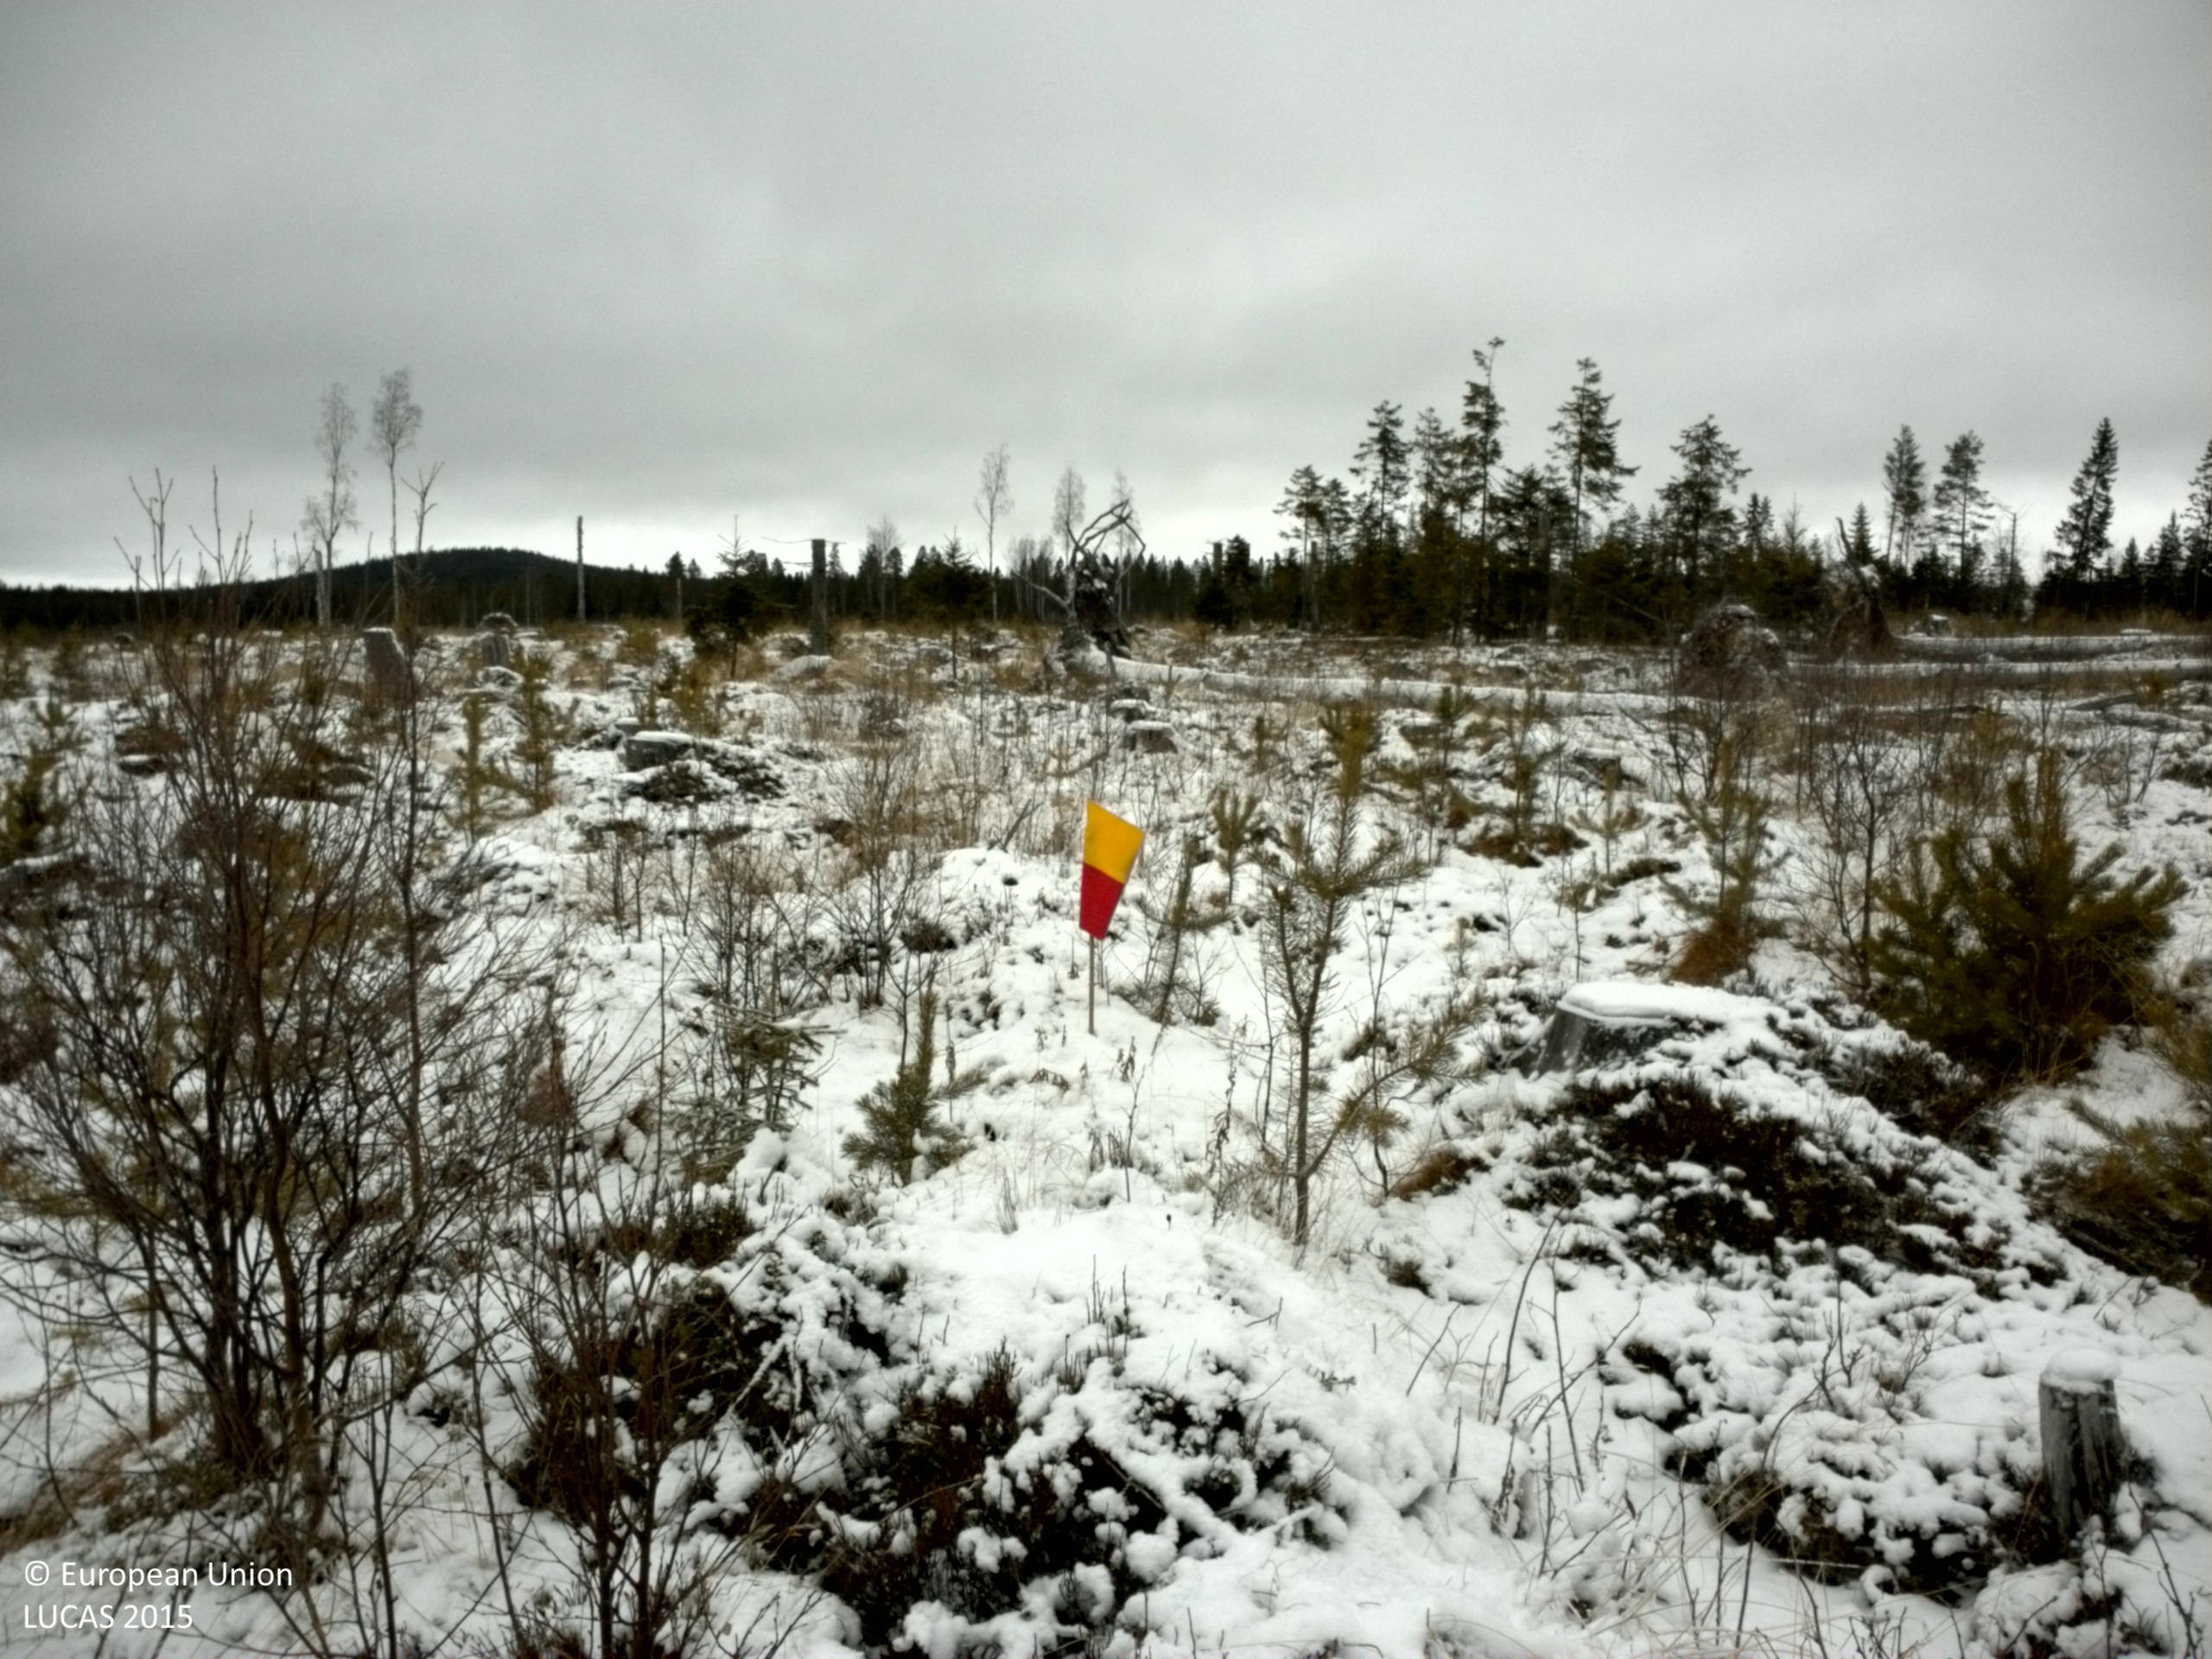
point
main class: Woodland
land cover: Pine dominated mixed woodland
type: boreal forest
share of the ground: 10 - 25 %
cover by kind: shrubs 50 %, lichens and mosses 25 %, coniferous forest trees 10 %, broadleaved forest trees 10 %, herbaceous plants 5 %
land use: Forestry
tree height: < 5 m
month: November
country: SE
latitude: 61.8235
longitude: 15.5449
